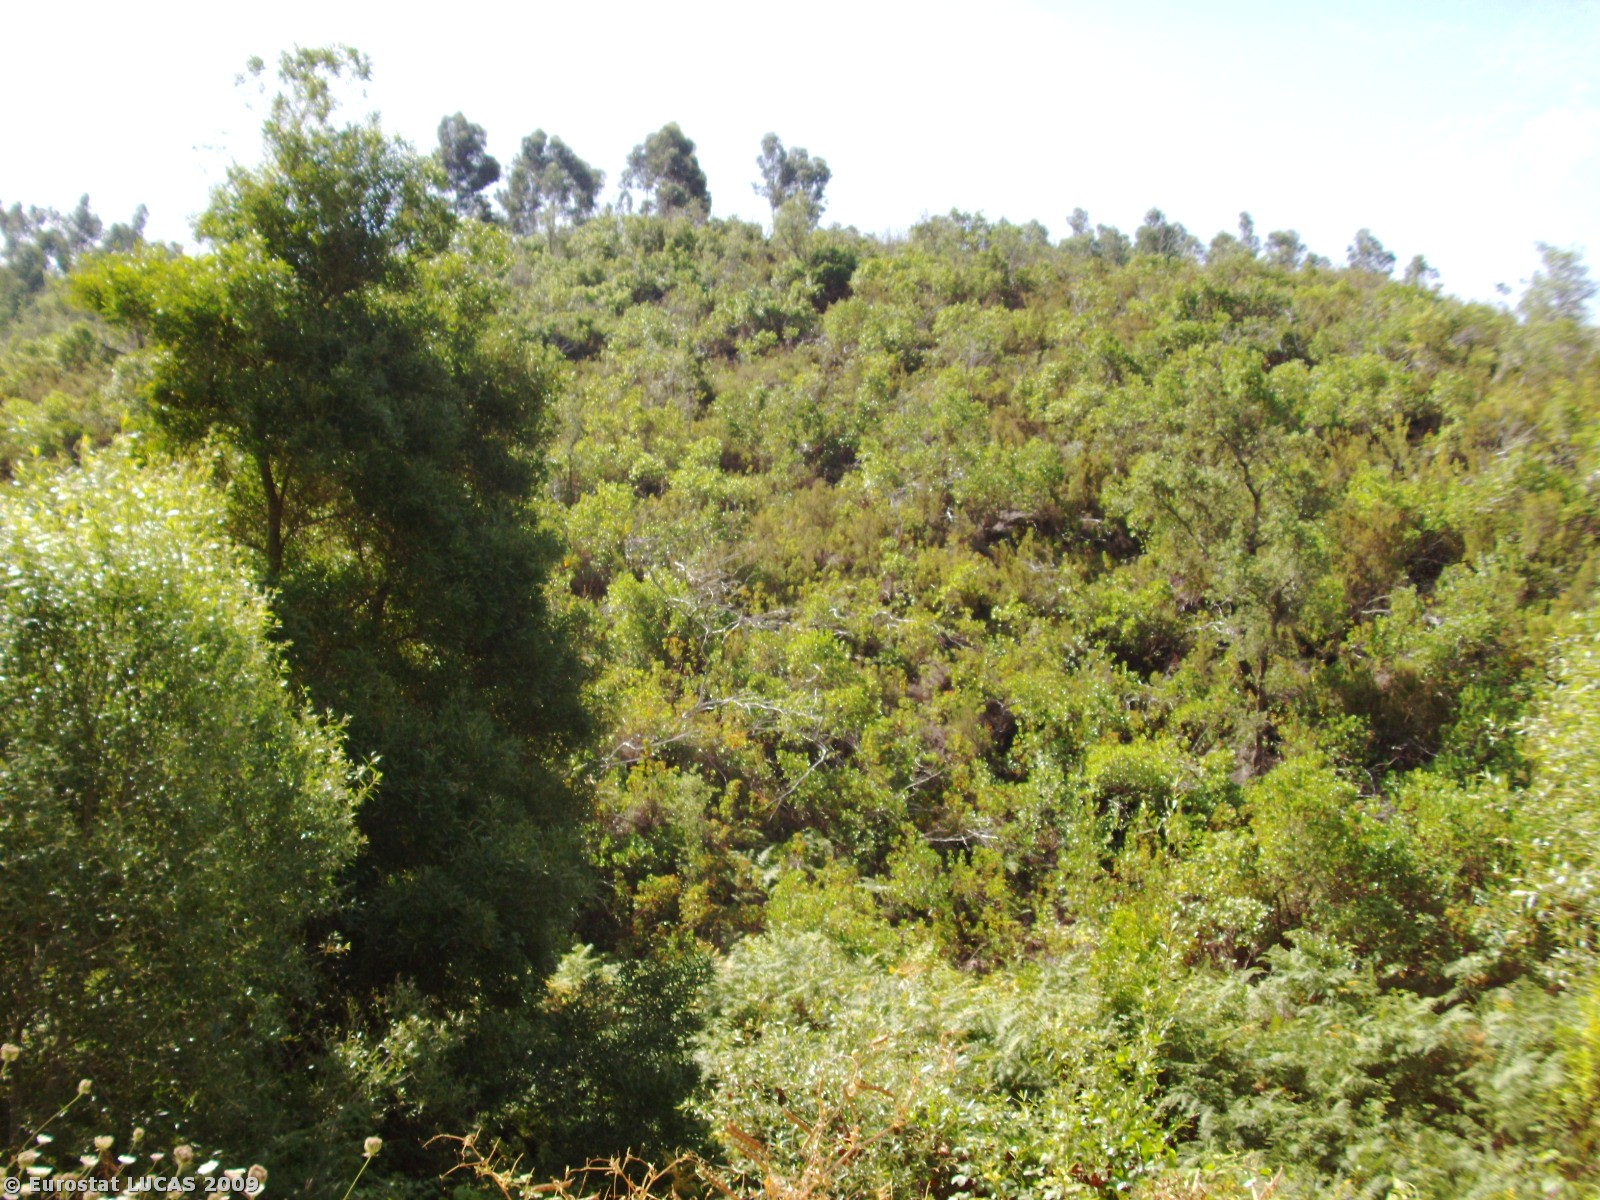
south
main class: Shrubland
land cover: Shrubland with sparse tree cover
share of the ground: > 75 %
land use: Unused
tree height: > 5 m
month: June
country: PT
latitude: 37.3499
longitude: -8.7411
